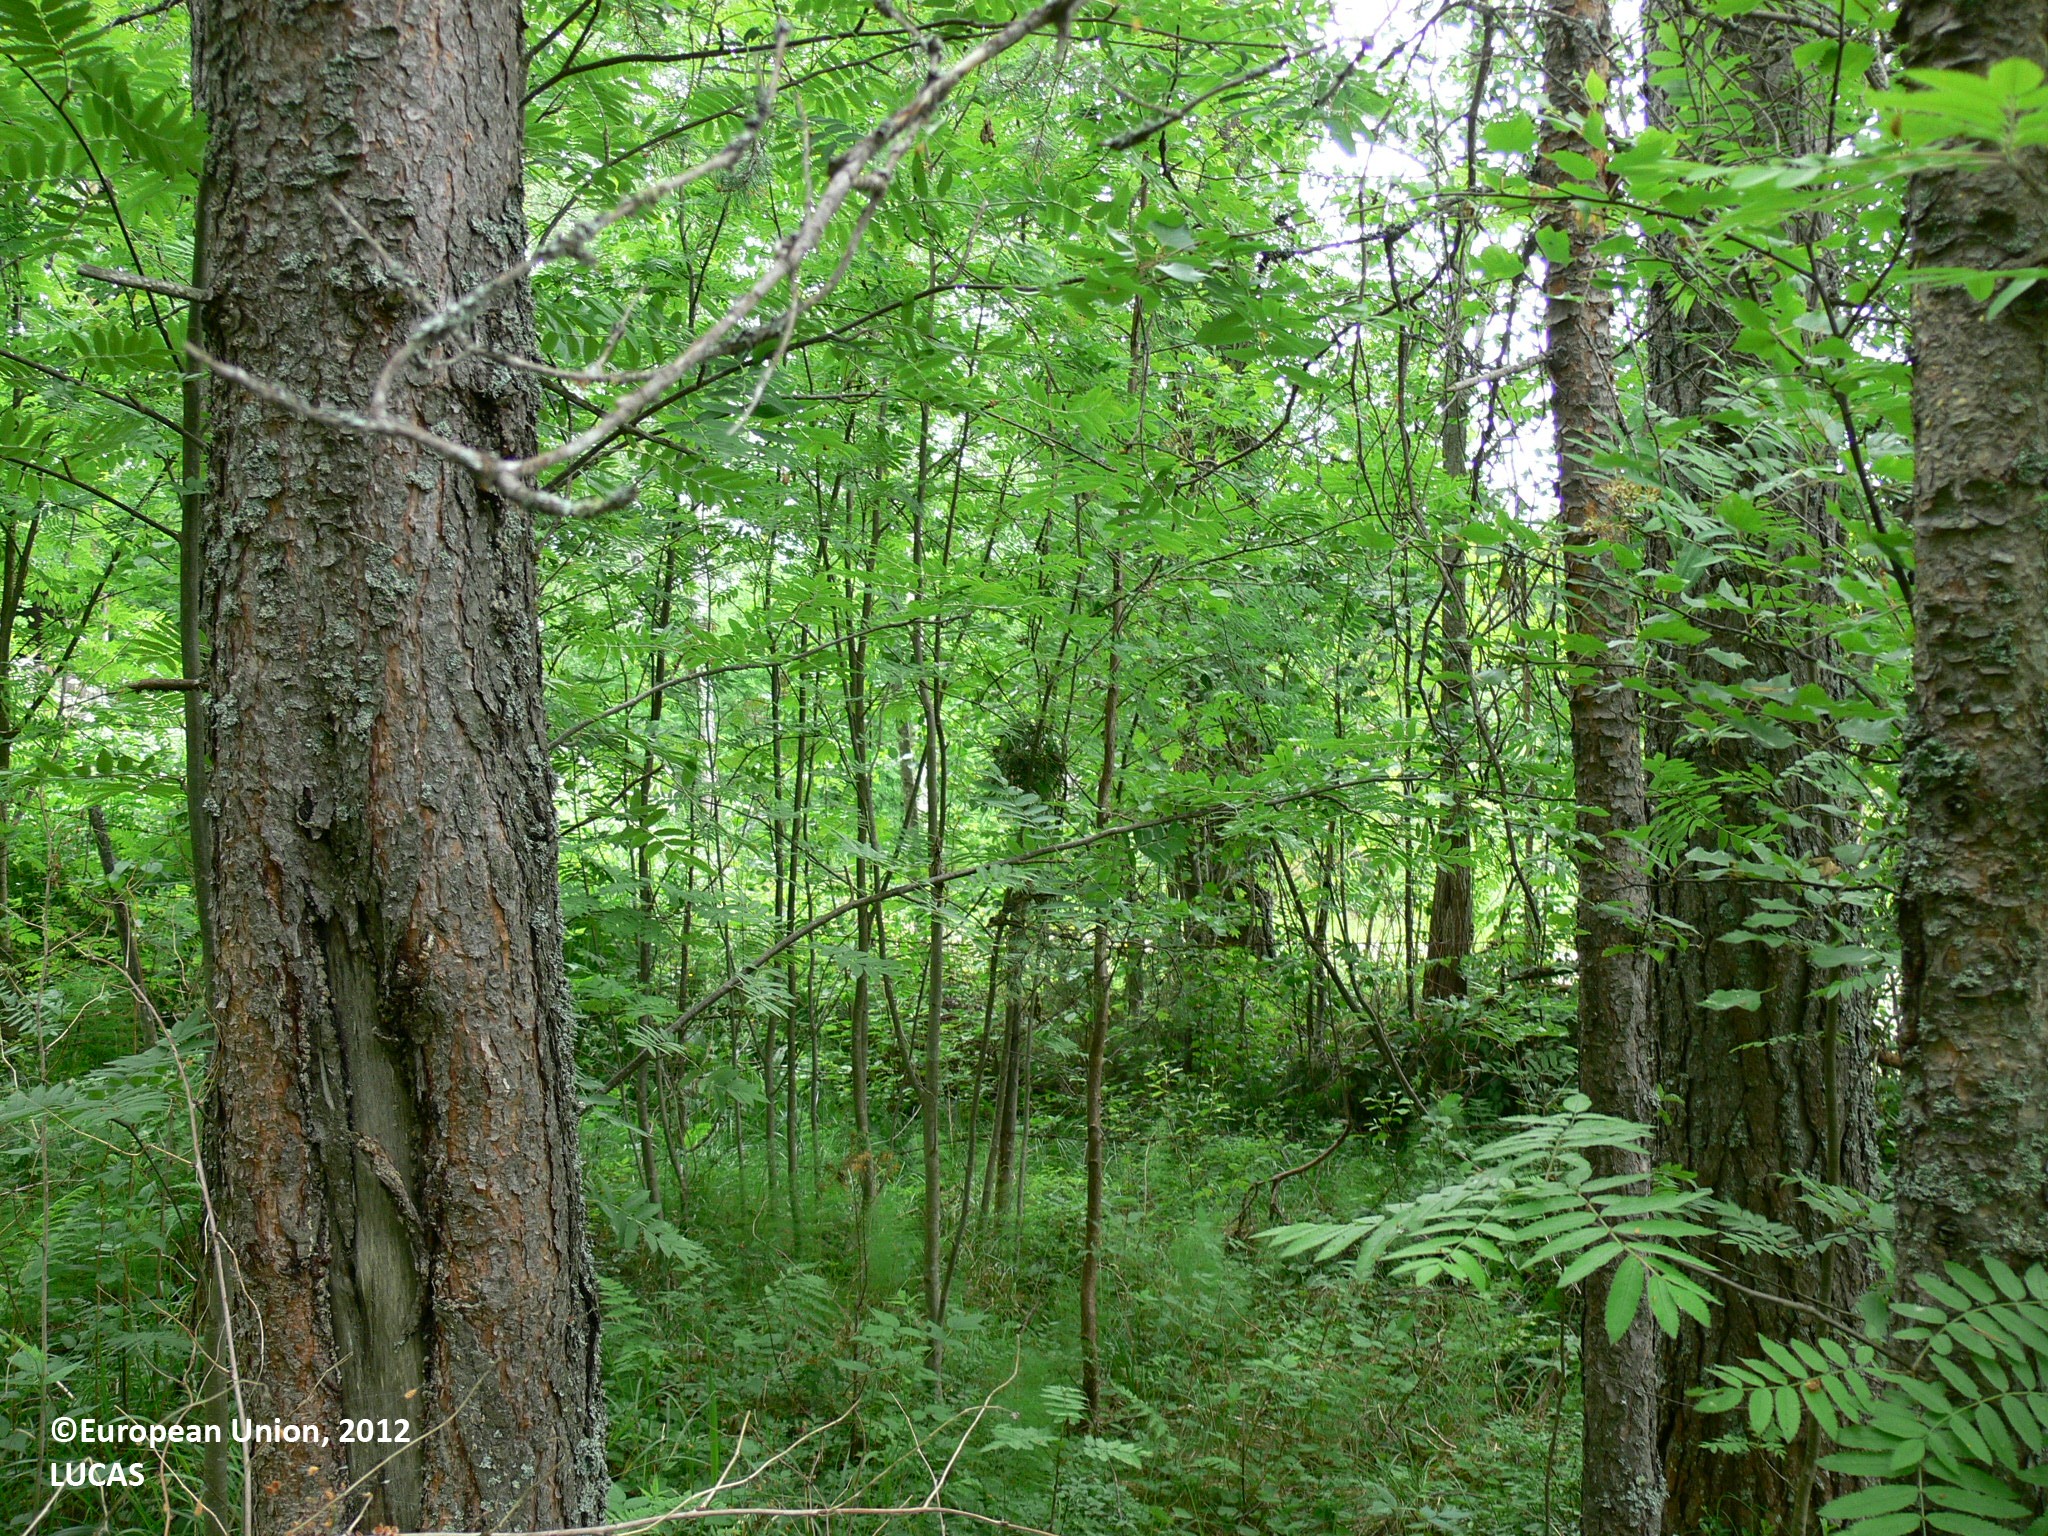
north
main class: Woodland
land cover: Pine dominated mixed woodland
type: boreal forest
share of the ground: > 75 %
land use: Forestry
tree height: > 5 m
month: June
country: FI
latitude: 62.7773
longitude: 29.3344
